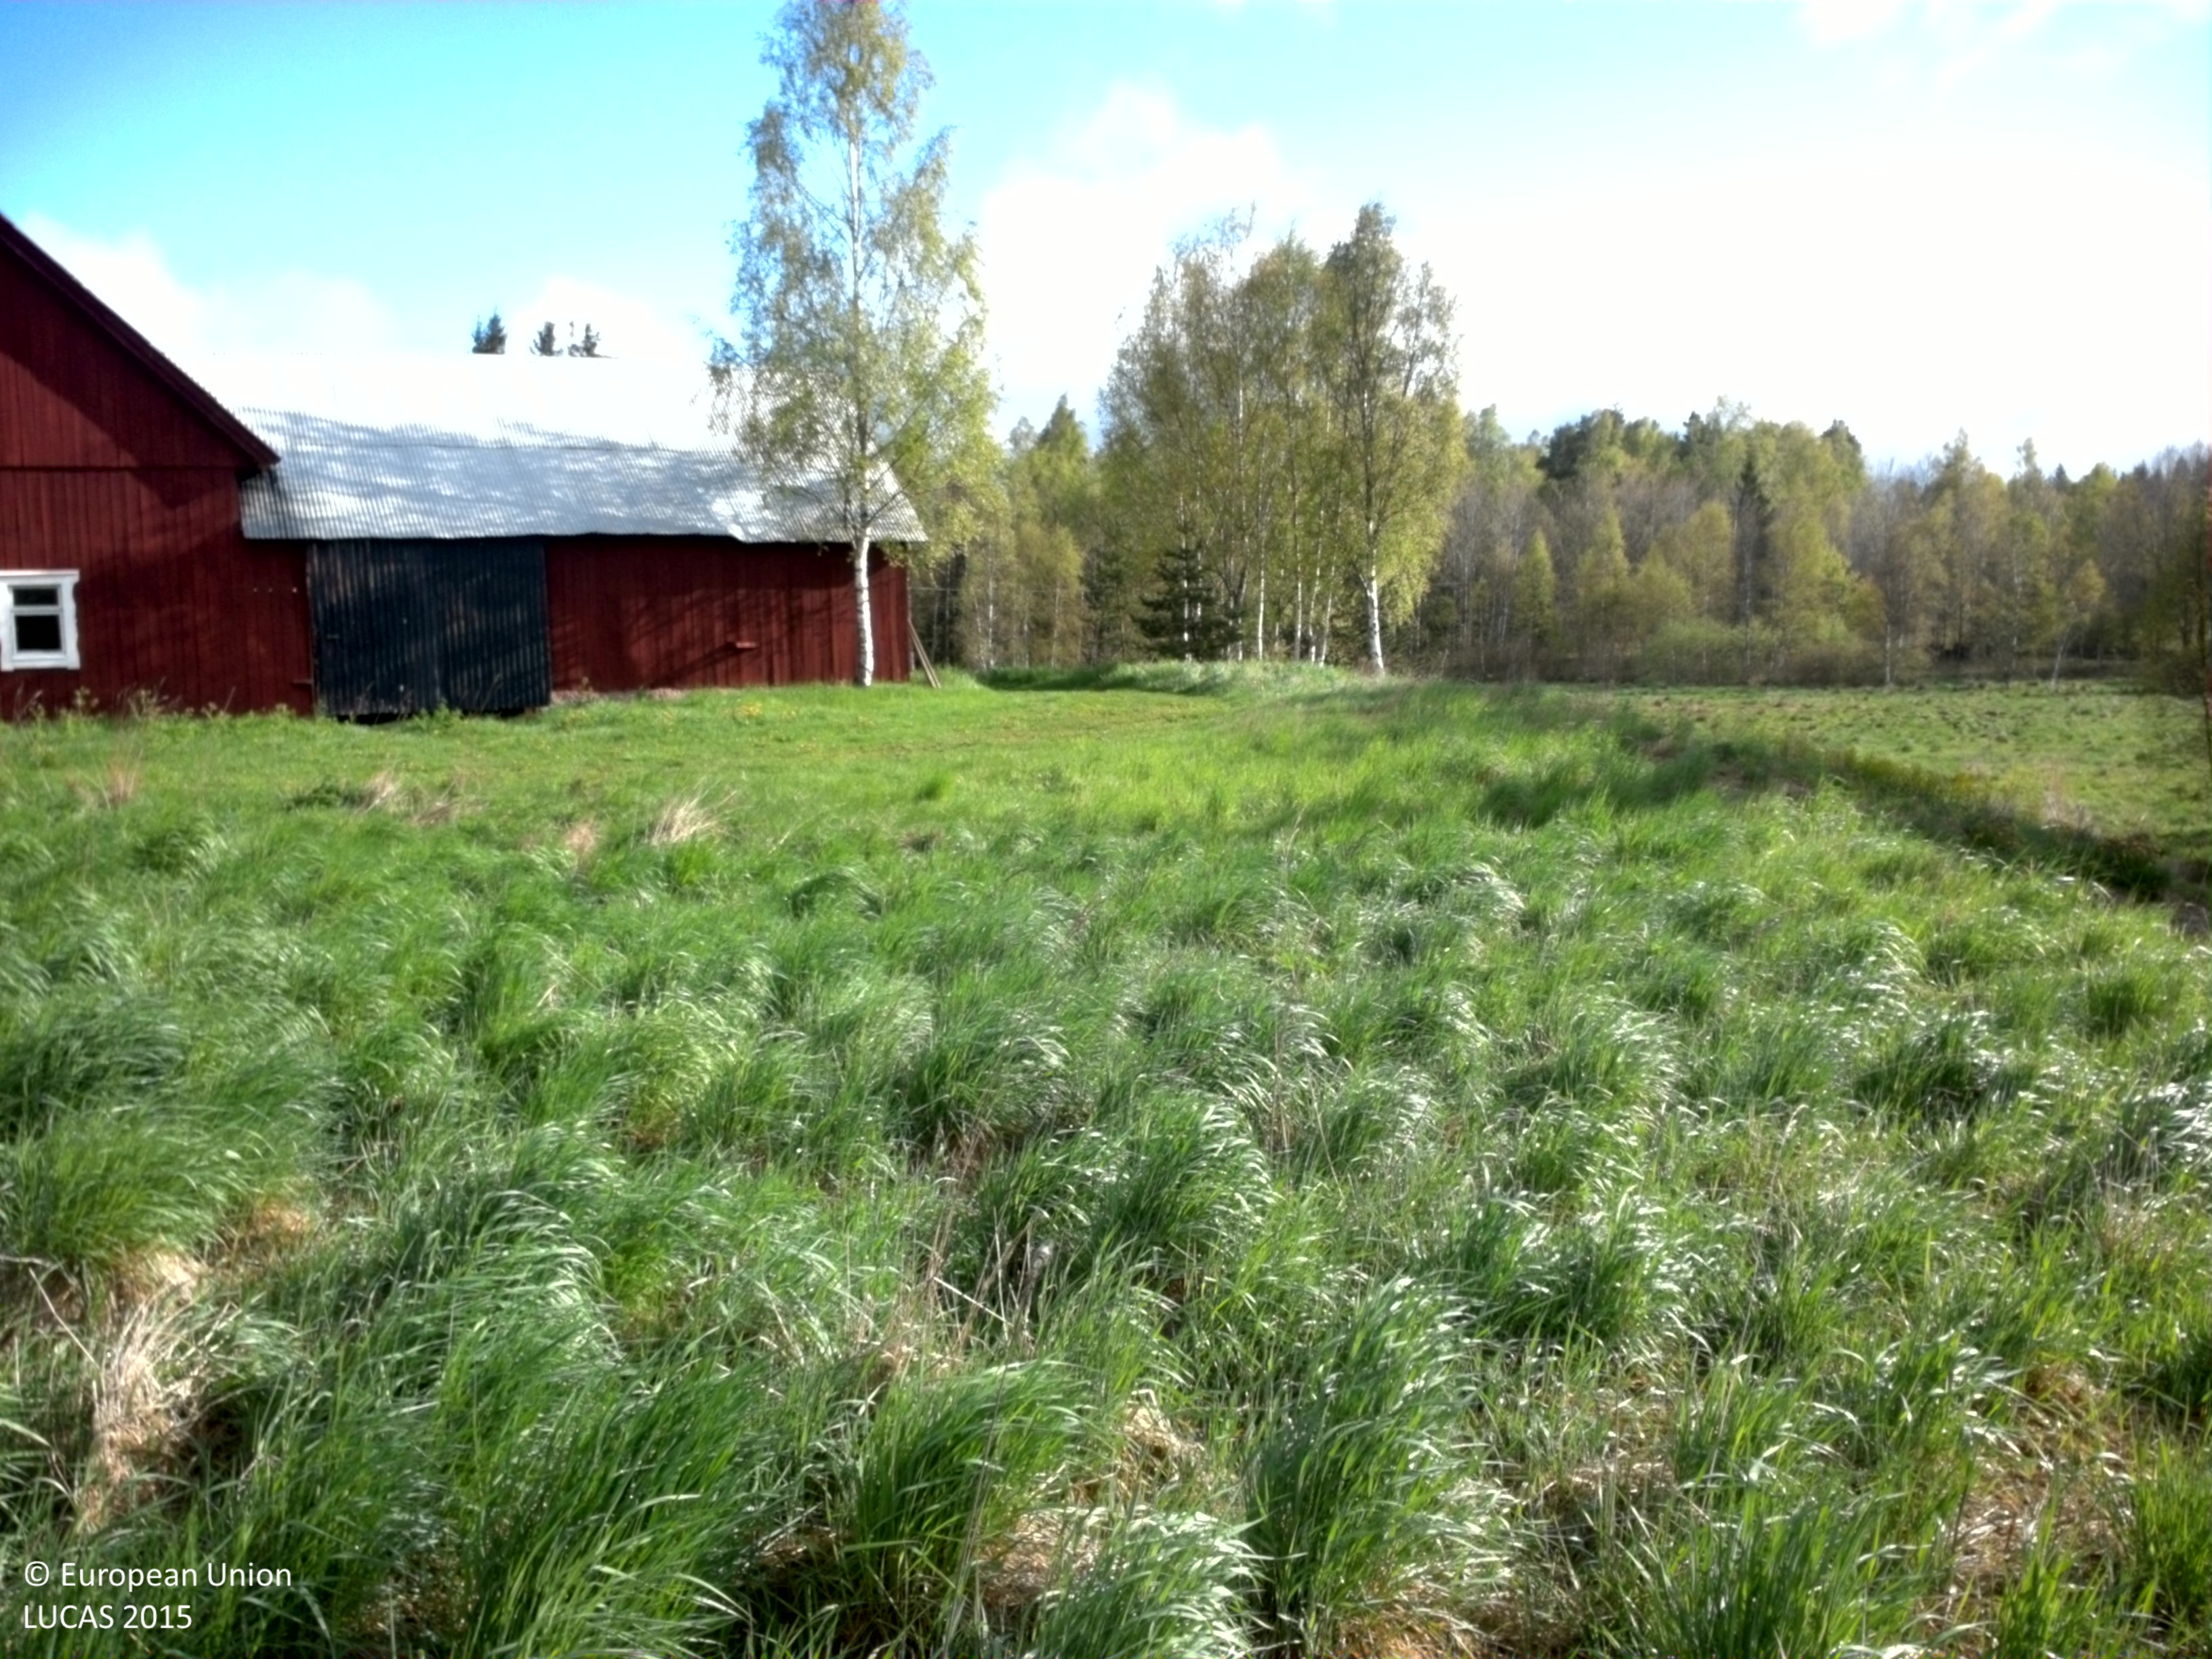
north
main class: Grassland
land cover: Grassland without tree/shrub cover
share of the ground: > 75 %
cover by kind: herbaceous plants 100 %
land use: Agriculture (excluding fallow land and kitchen gardens)
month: May
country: SE
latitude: 56.8342
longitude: 14.8651
